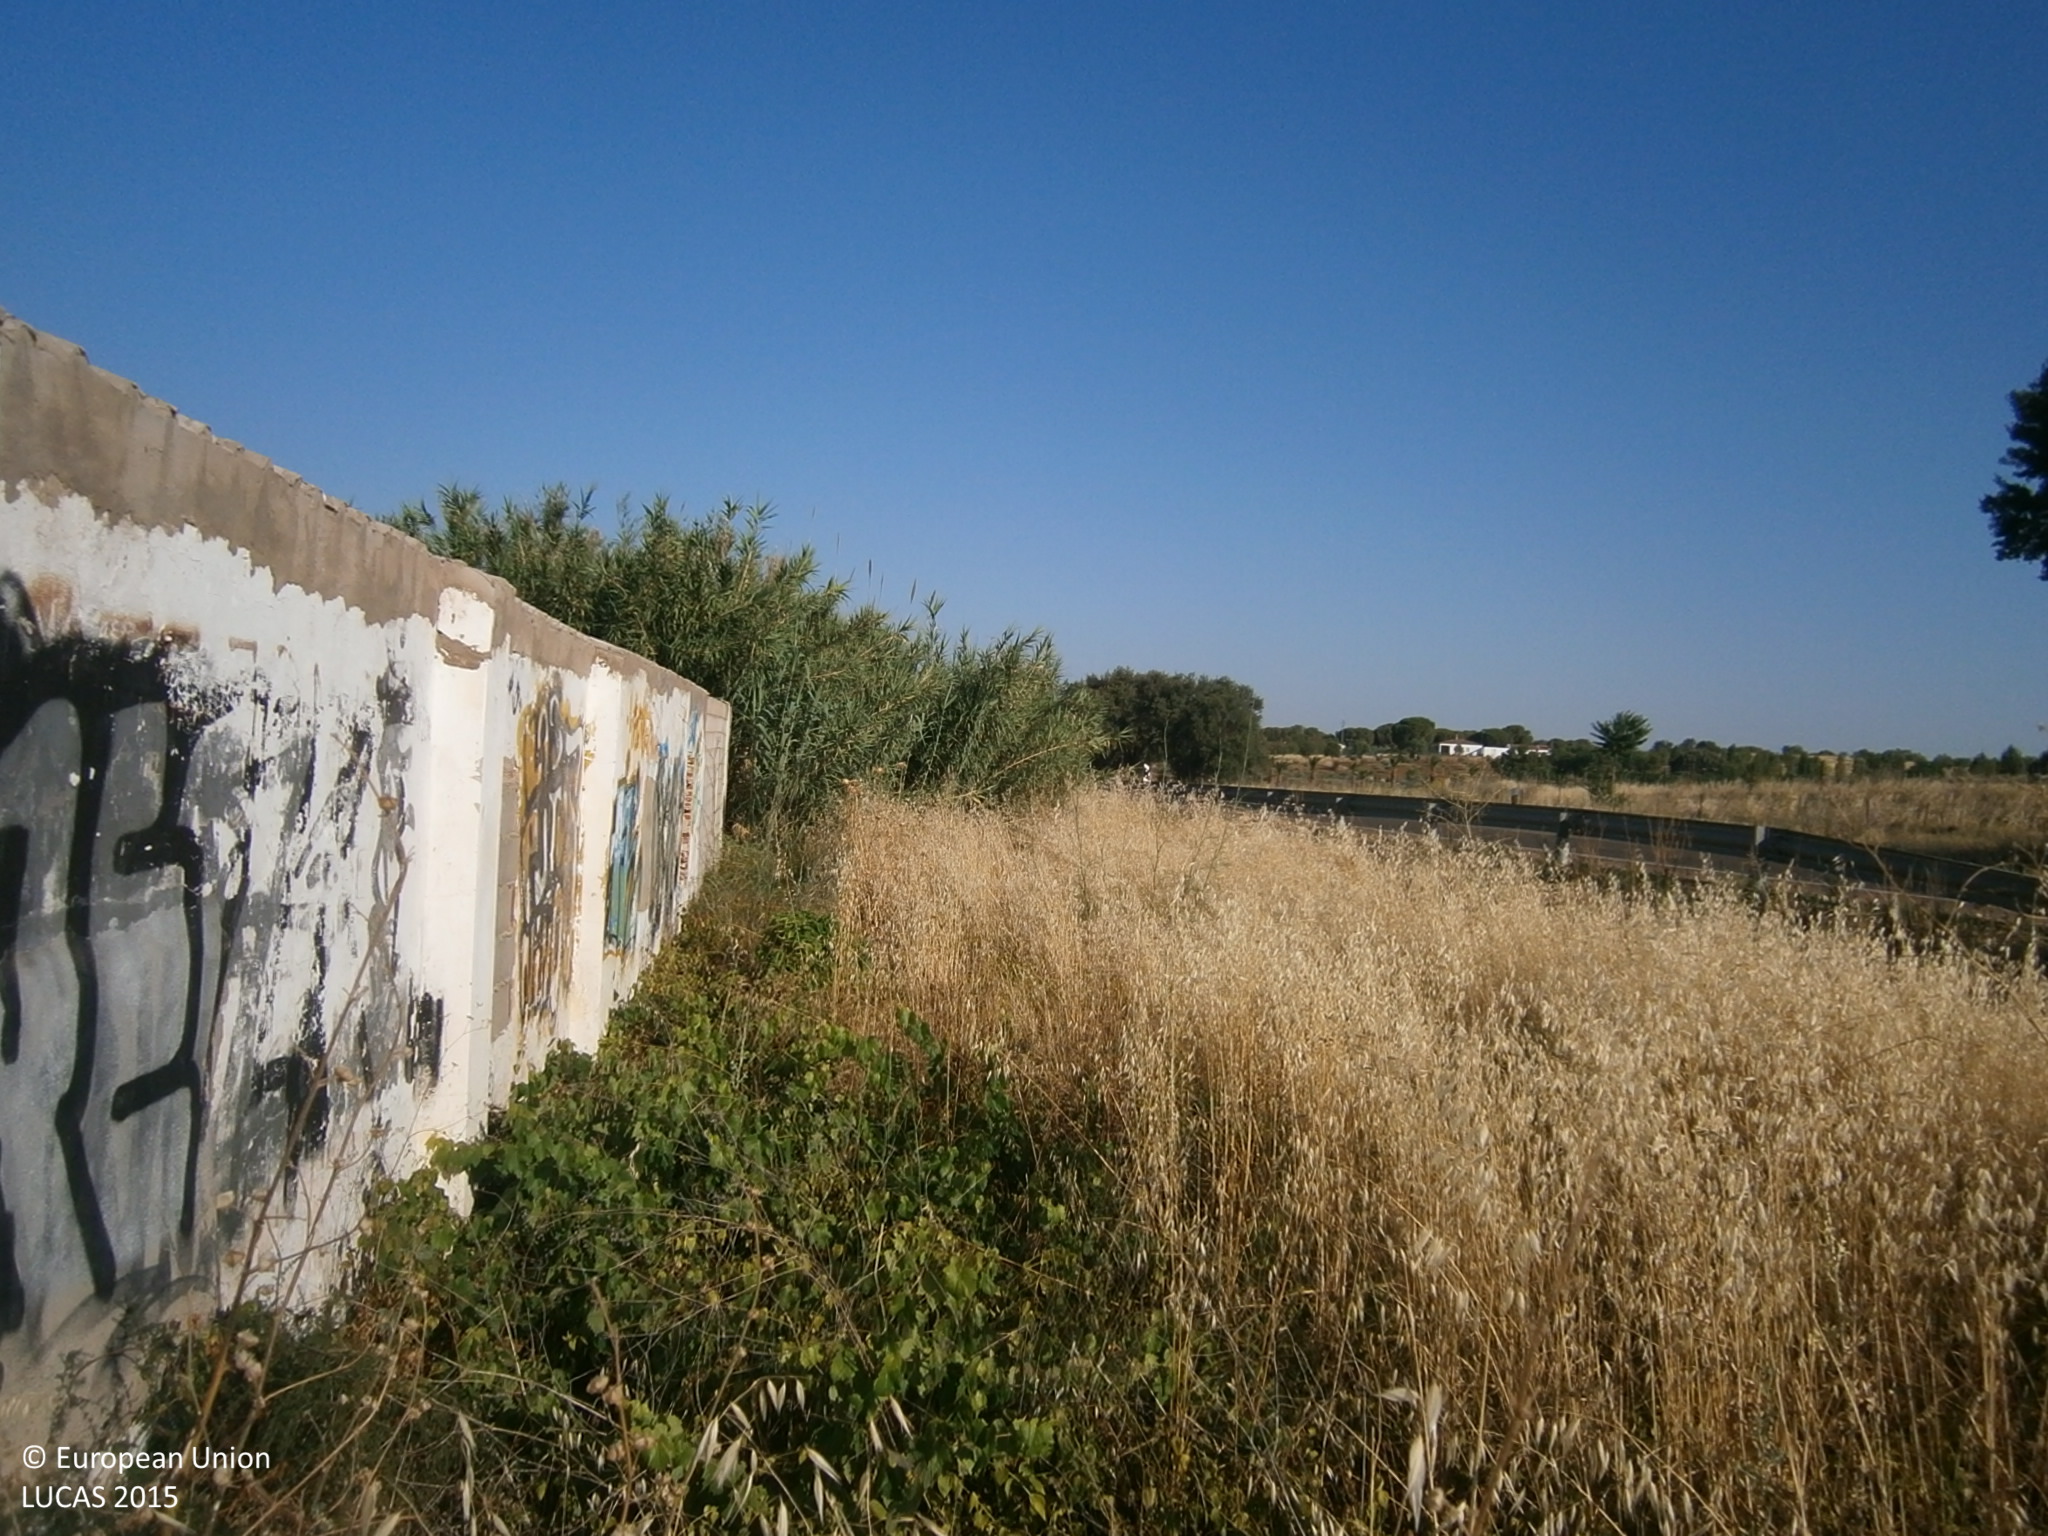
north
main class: Cropland
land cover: Oats
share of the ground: > 75 %
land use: Agriculture (excluding fallow land and kitchen gardens)
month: June
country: ES
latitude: 38.8092
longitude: -6.8915
